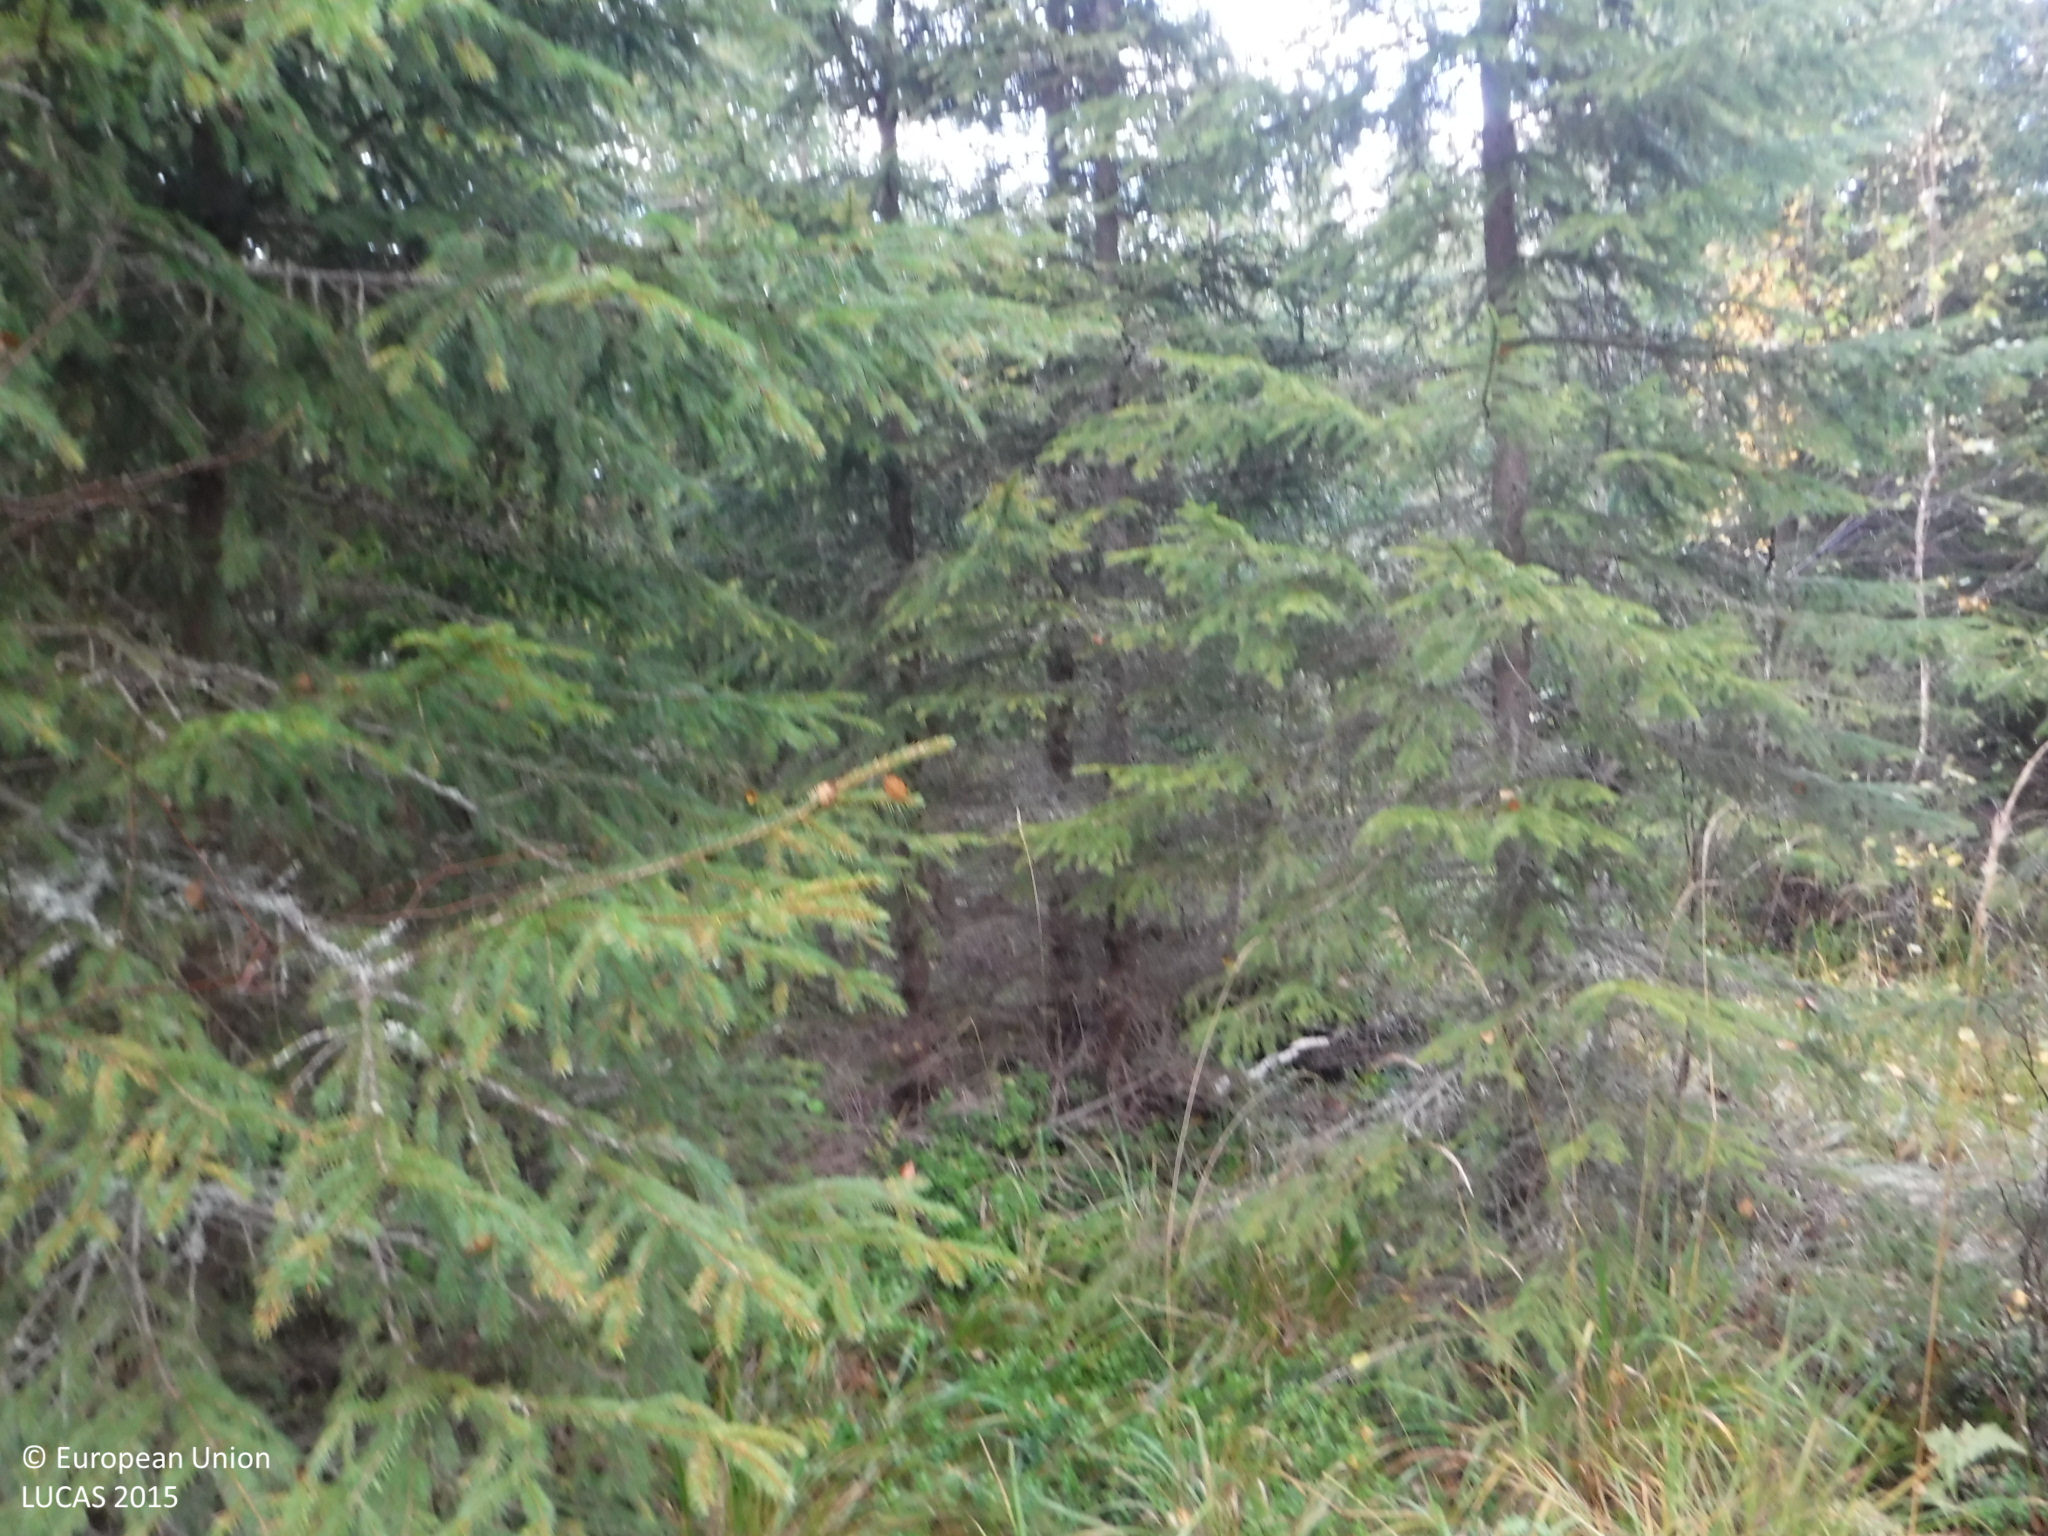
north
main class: Woodland
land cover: Spruce dominated coniferous woodland
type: boreal forest
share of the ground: 50 - 75 %
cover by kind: coniferous forest trees 55 %, herbaceous plants 40 %, lichens and mosses 5 %
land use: Forestry
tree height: > 5 m
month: September
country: FI
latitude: 61.7053
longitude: 24.1022
